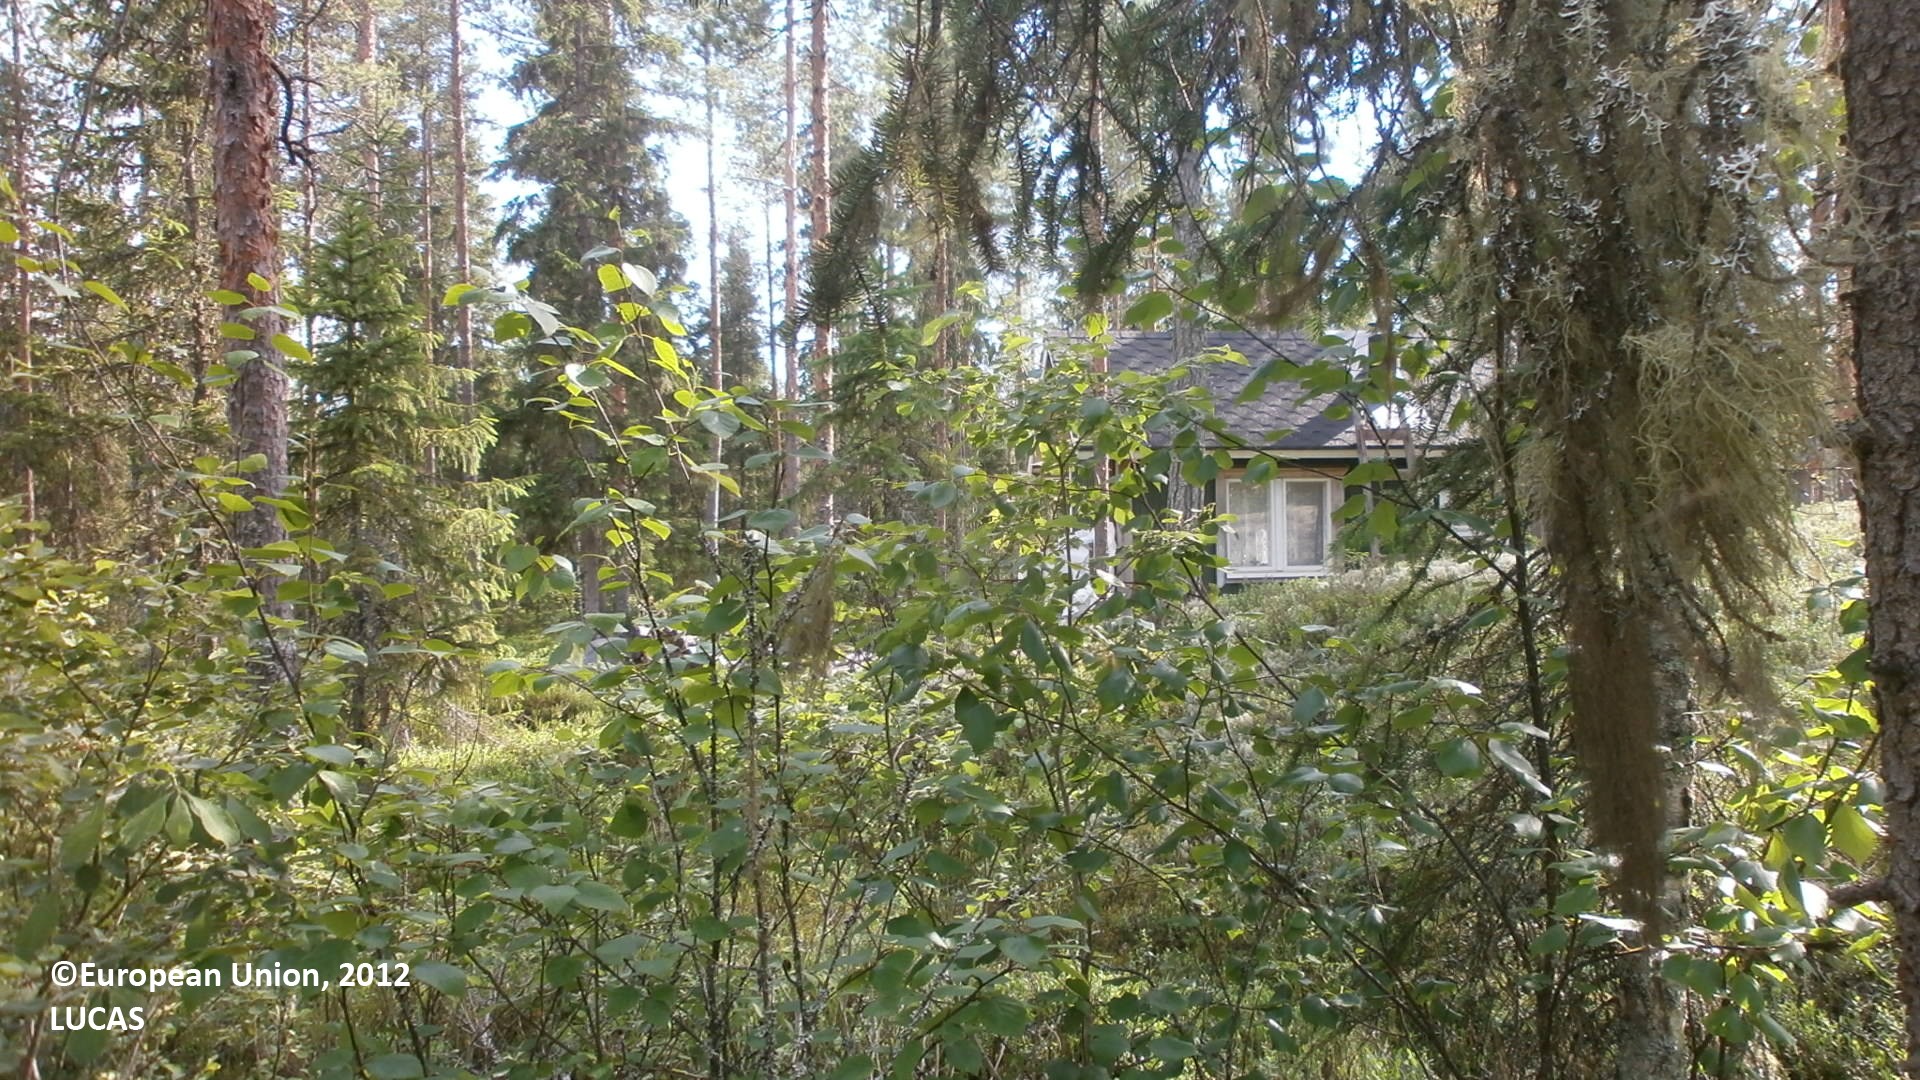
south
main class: Woodland
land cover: Other coniferous woodland
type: boreal forest
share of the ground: 50 - 75 %
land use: Forestry
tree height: > 5 m
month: July
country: FI
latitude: 64.3054
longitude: 24.2263
